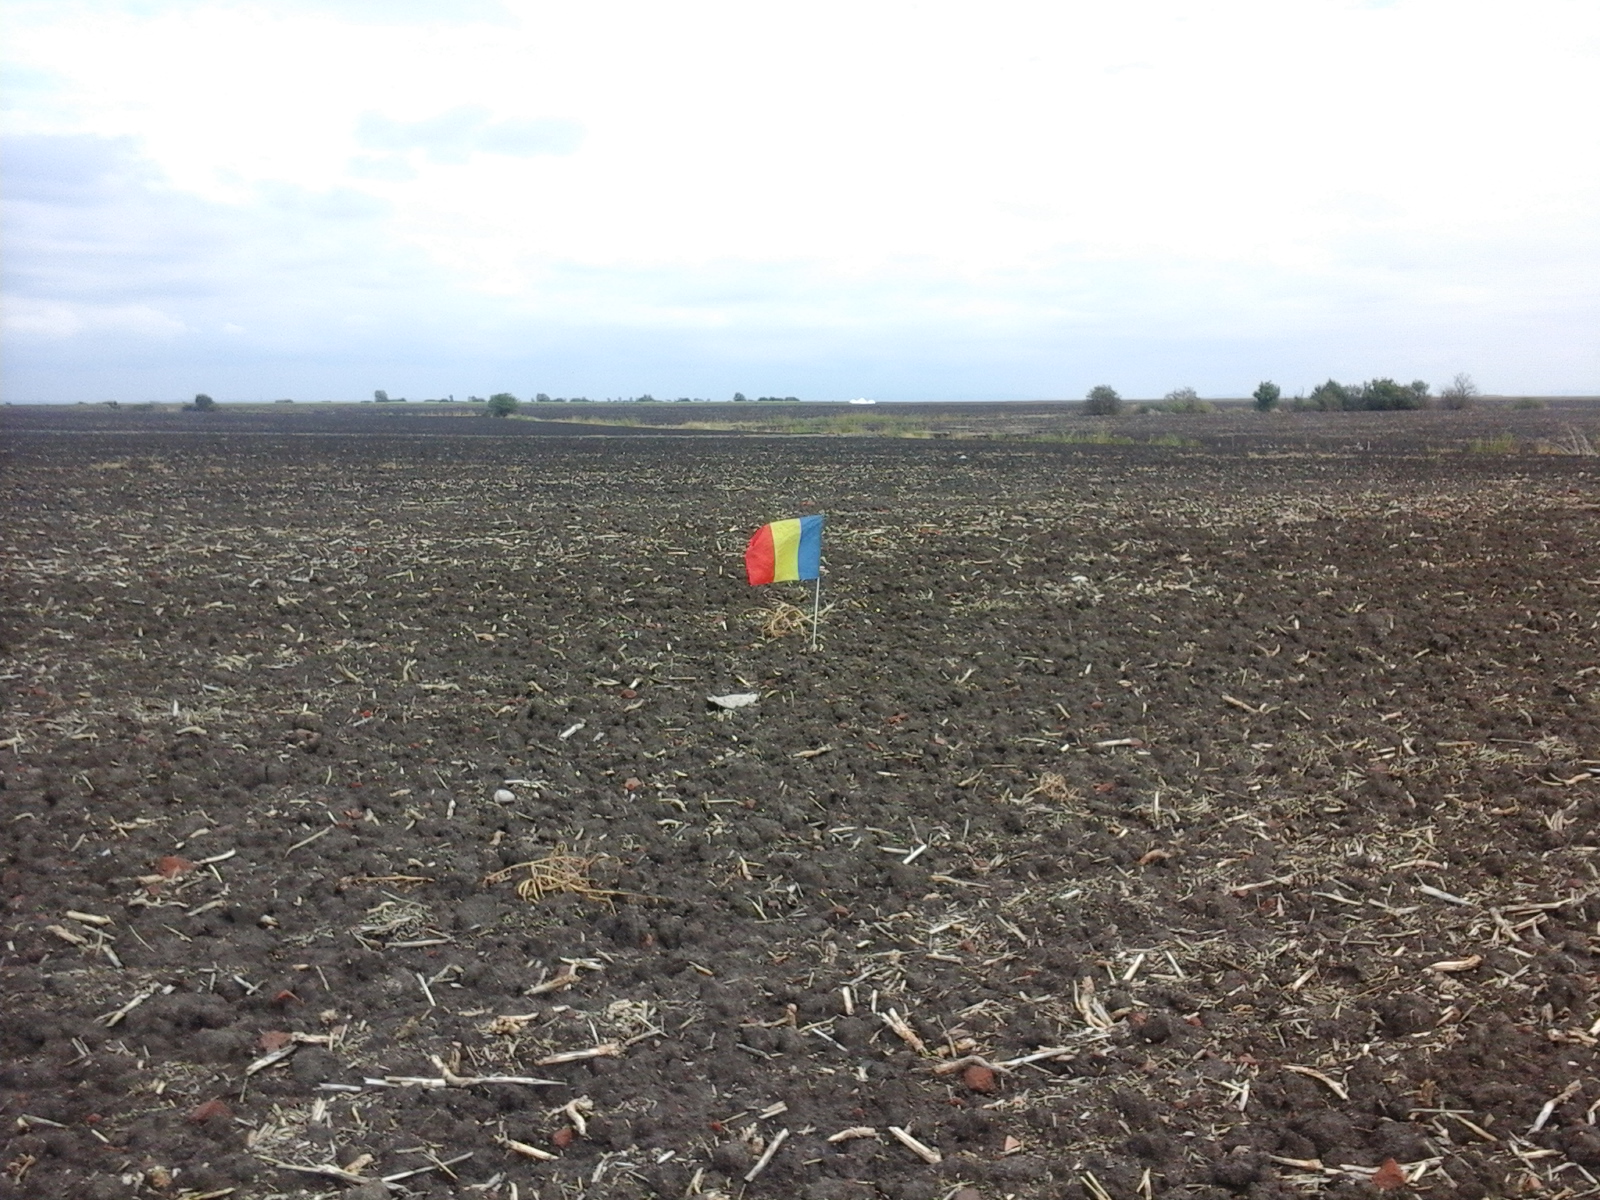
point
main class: Cropland
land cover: Rape and turnip rape
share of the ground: < 10 %
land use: Agriculture (excluding fallow land and kitchen gardens)
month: August
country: RO
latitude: 45.5104
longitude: 21.3328
